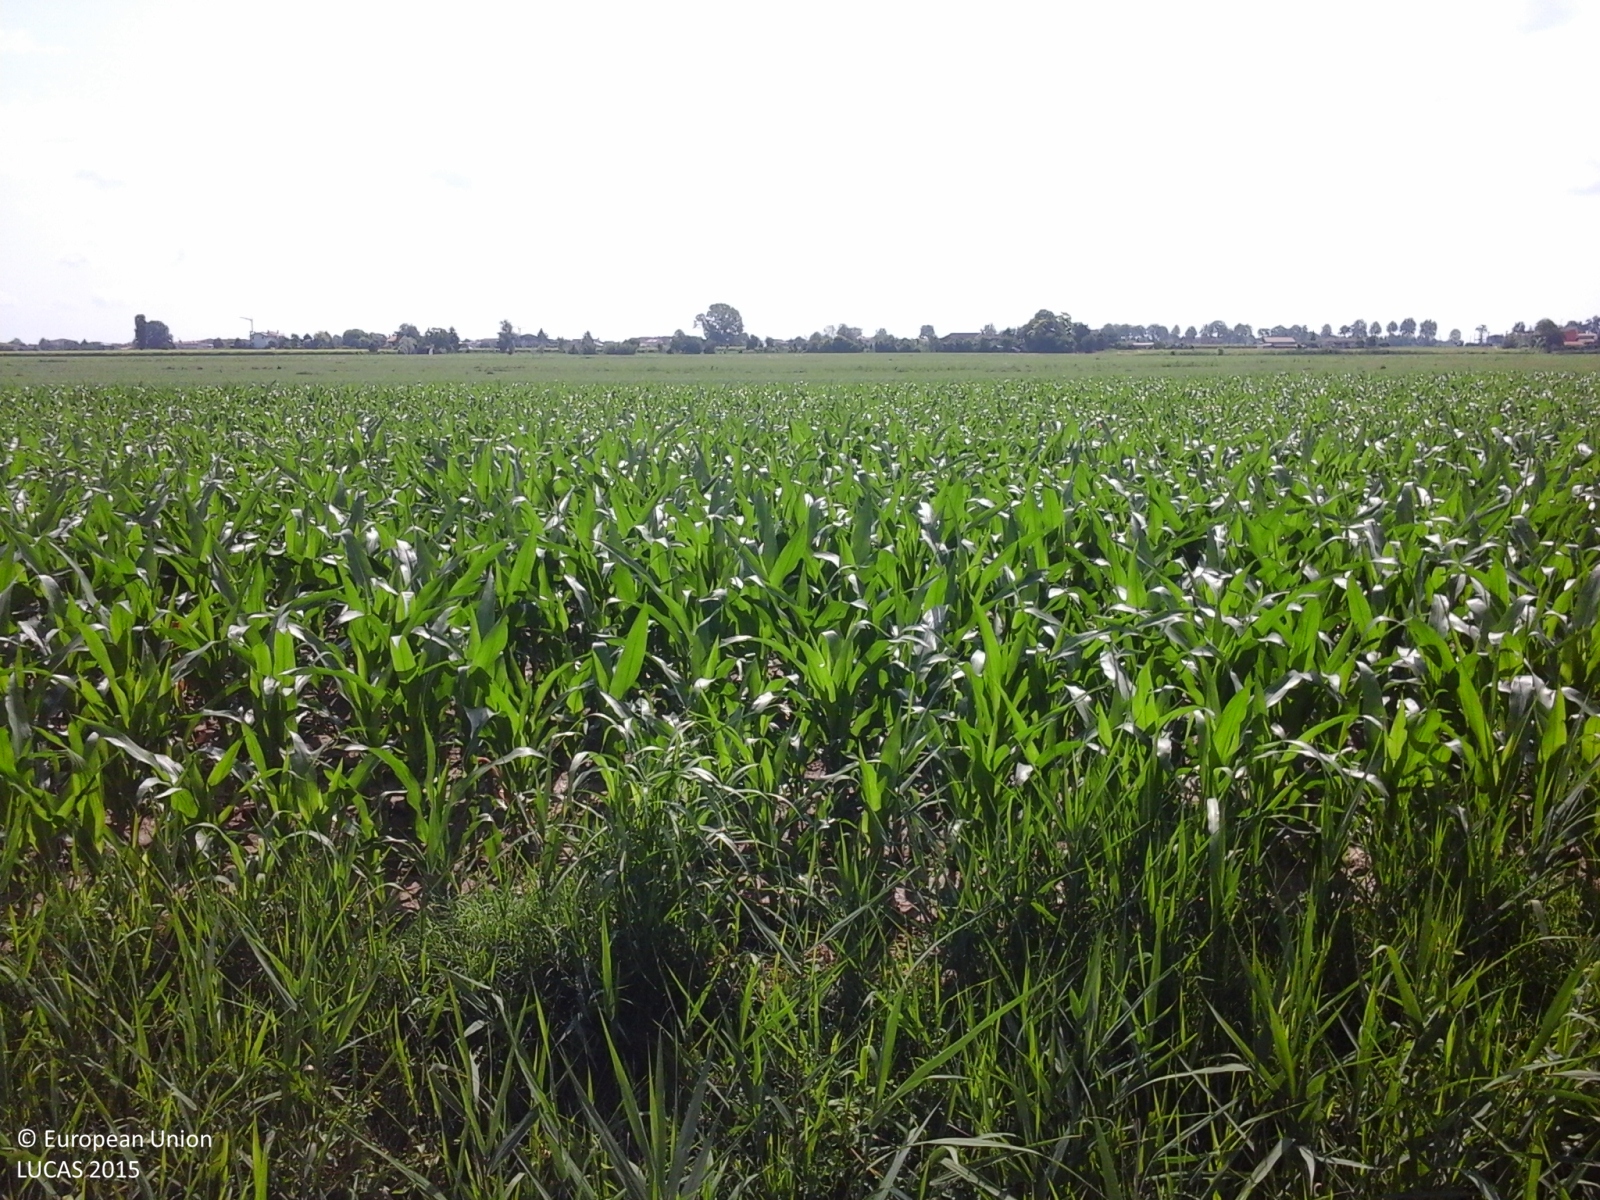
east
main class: Cropland
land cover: Maize
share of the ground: > 75 %
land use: Agriculture (excluding fallow land and kitchen gardens)
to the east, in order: Maize; Ditches and canals; Maize; Ditches and canals; Soya; Ditches and canals; Soya; Ditches and canals; Soya; Ditches and canals; Soya; Ditches and canals; Soya; Ditches and canals; Soya; Ditches and canals; Soya; Ditches and canals; Soya
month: June
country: IT
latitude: 45.5967
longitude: 12.6755
